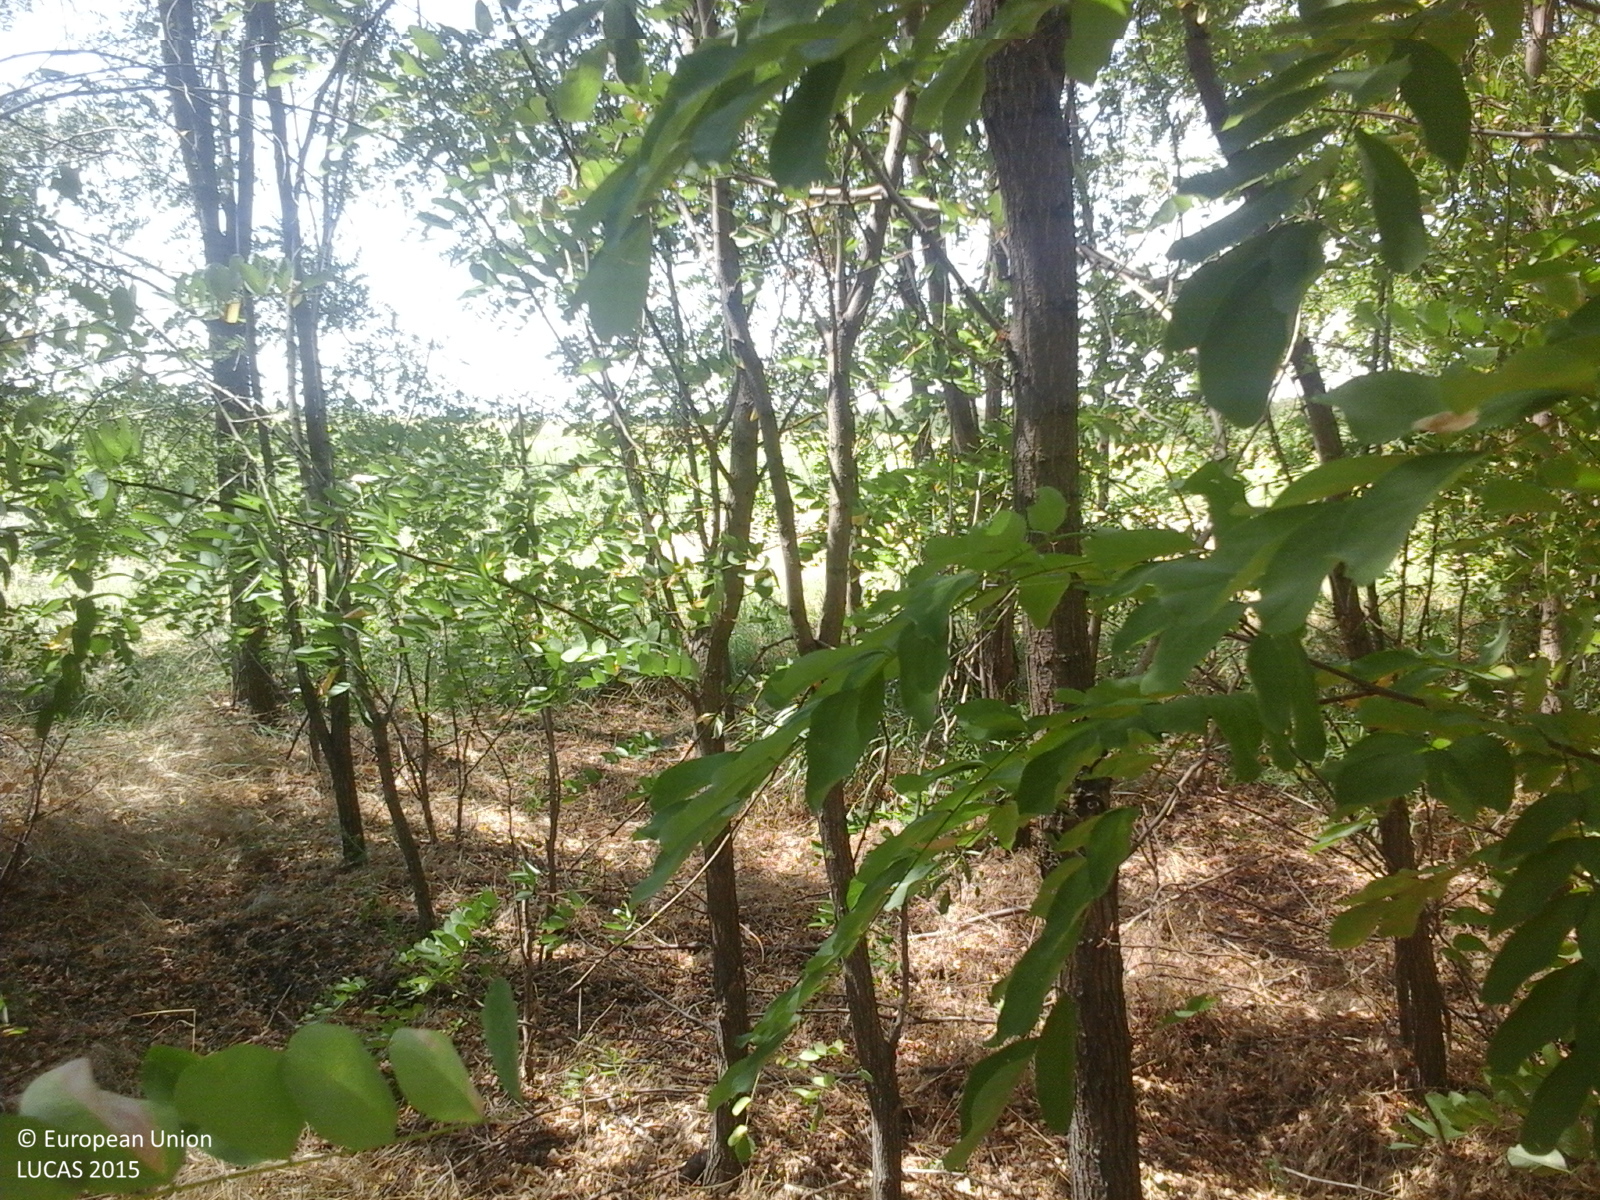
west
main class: Woodland
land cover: Broadleaved woodland
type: exotic forest
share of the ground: > 75 %
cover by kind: broadleaved forest trees 100 %
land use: Forestry
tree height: > 5 m
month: August
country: RO
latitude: 45.8160
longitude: 27.4920
